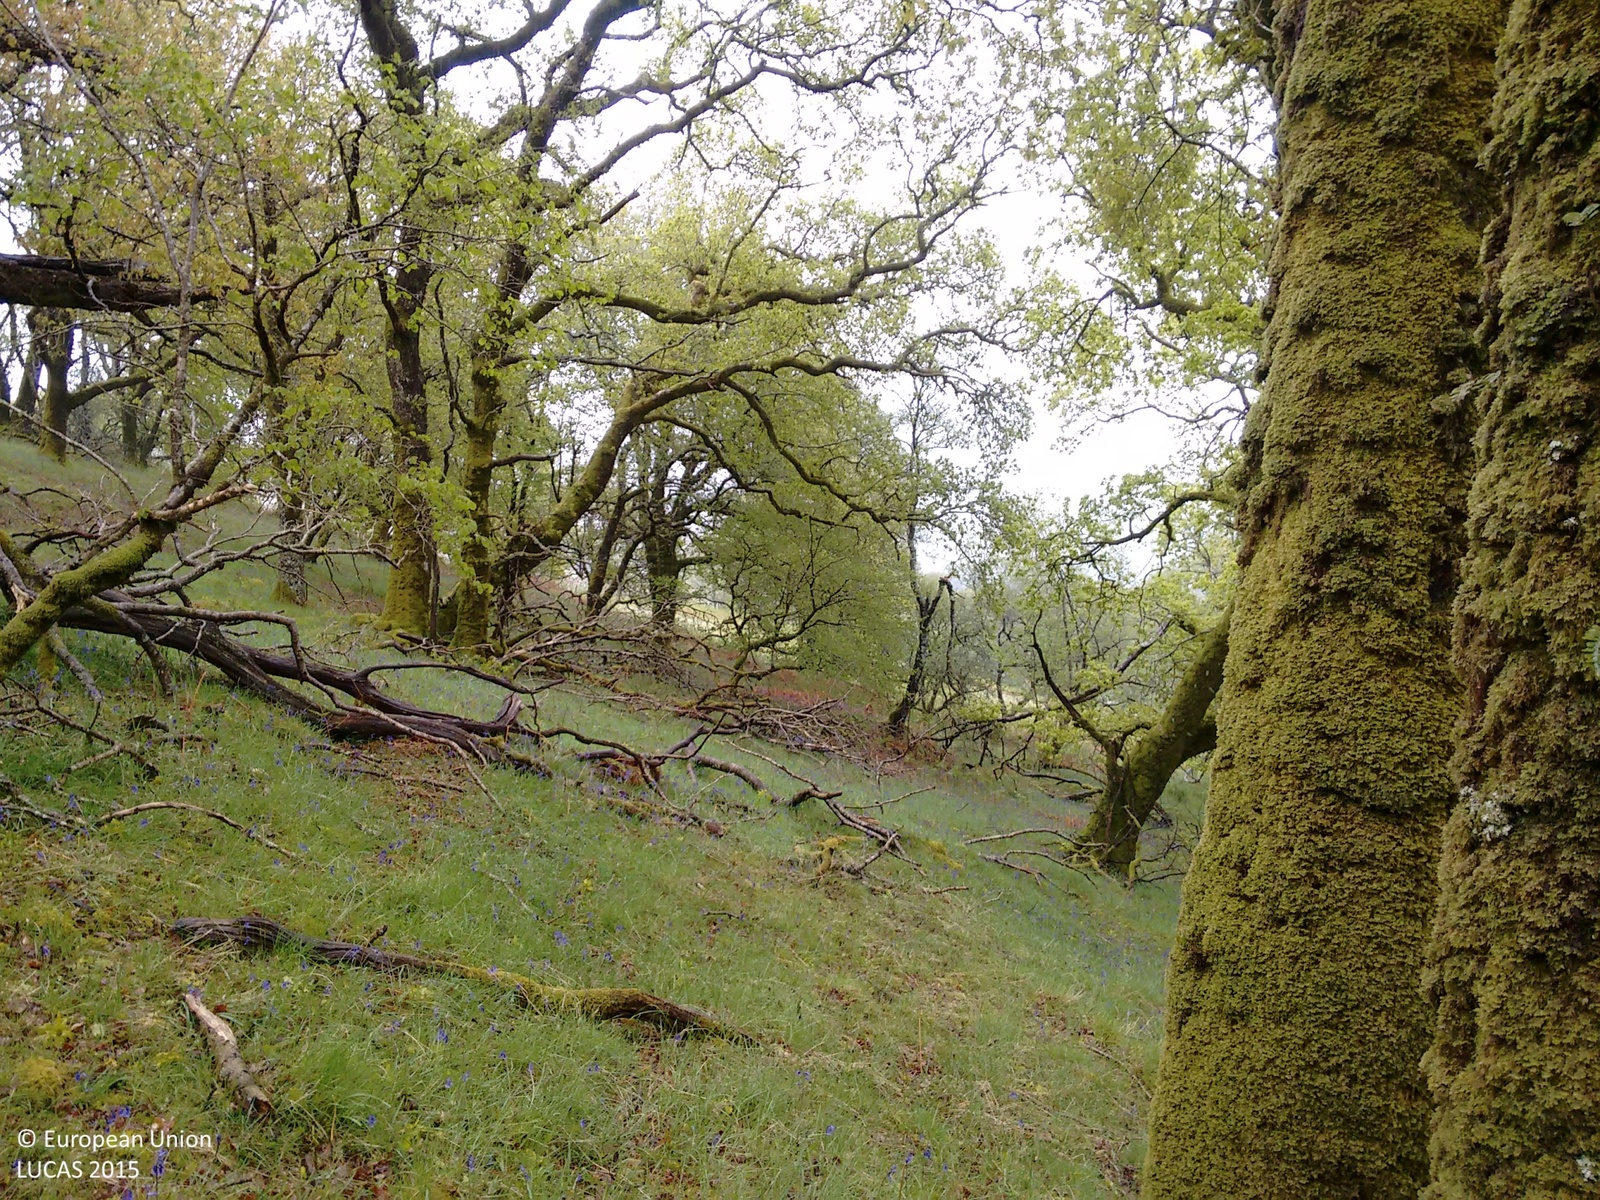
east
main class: Woodland
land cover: Broadleaved woodland
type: acidophilous oak and oak-birch forest
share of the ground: > 75 %
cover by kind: broadleaved forest trees 100 %
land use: Semi-natural and natural areas not in use
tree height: > 5 m
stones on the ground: 10 - 25 %
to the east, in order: Broadleaved woodland; Grassland with sparse tree/shrub cover; Shrubland with sparse tree cover; Grassland with sparse tree/shrub cover
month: June
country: GB
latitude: 56.1548
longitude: -5.1990
